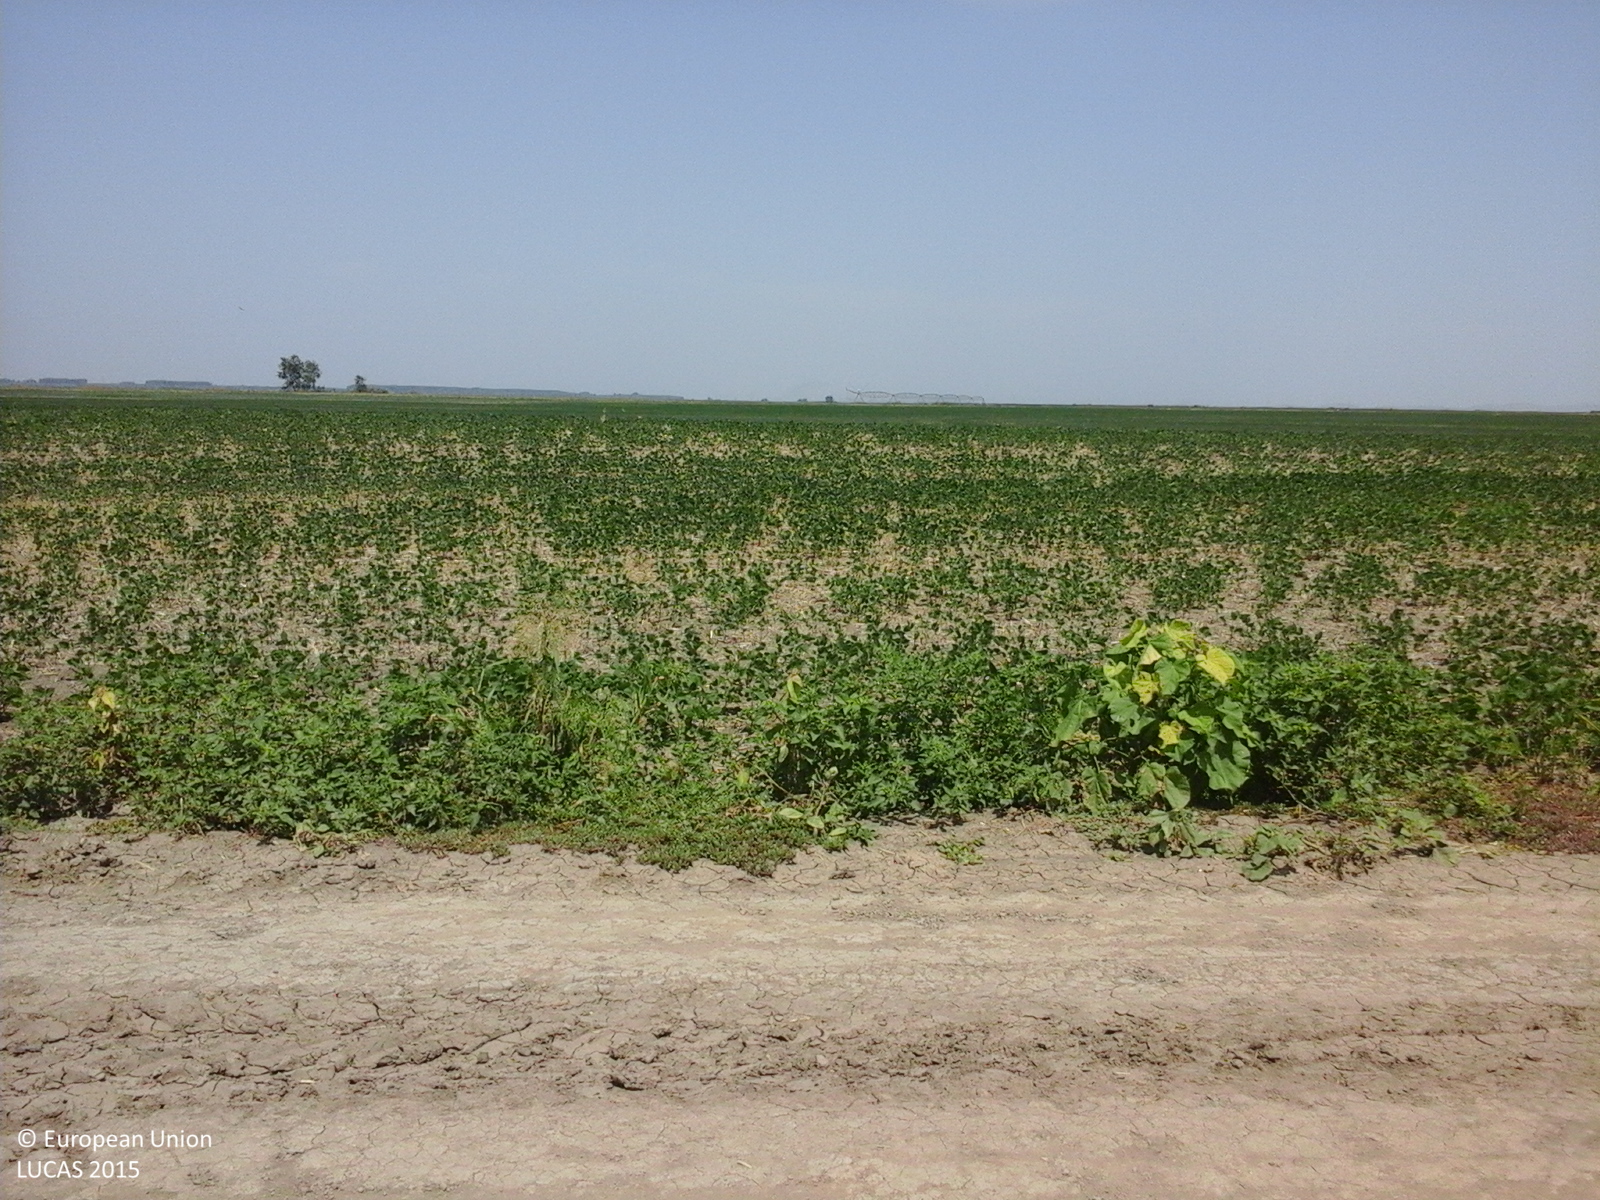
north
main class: Cropland
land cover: Soya
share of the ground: > 75 %
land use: Agriculture (excluding fallow land and kitchen gardens)
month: August
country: RO
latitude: 45.1036
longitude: 27.9950
